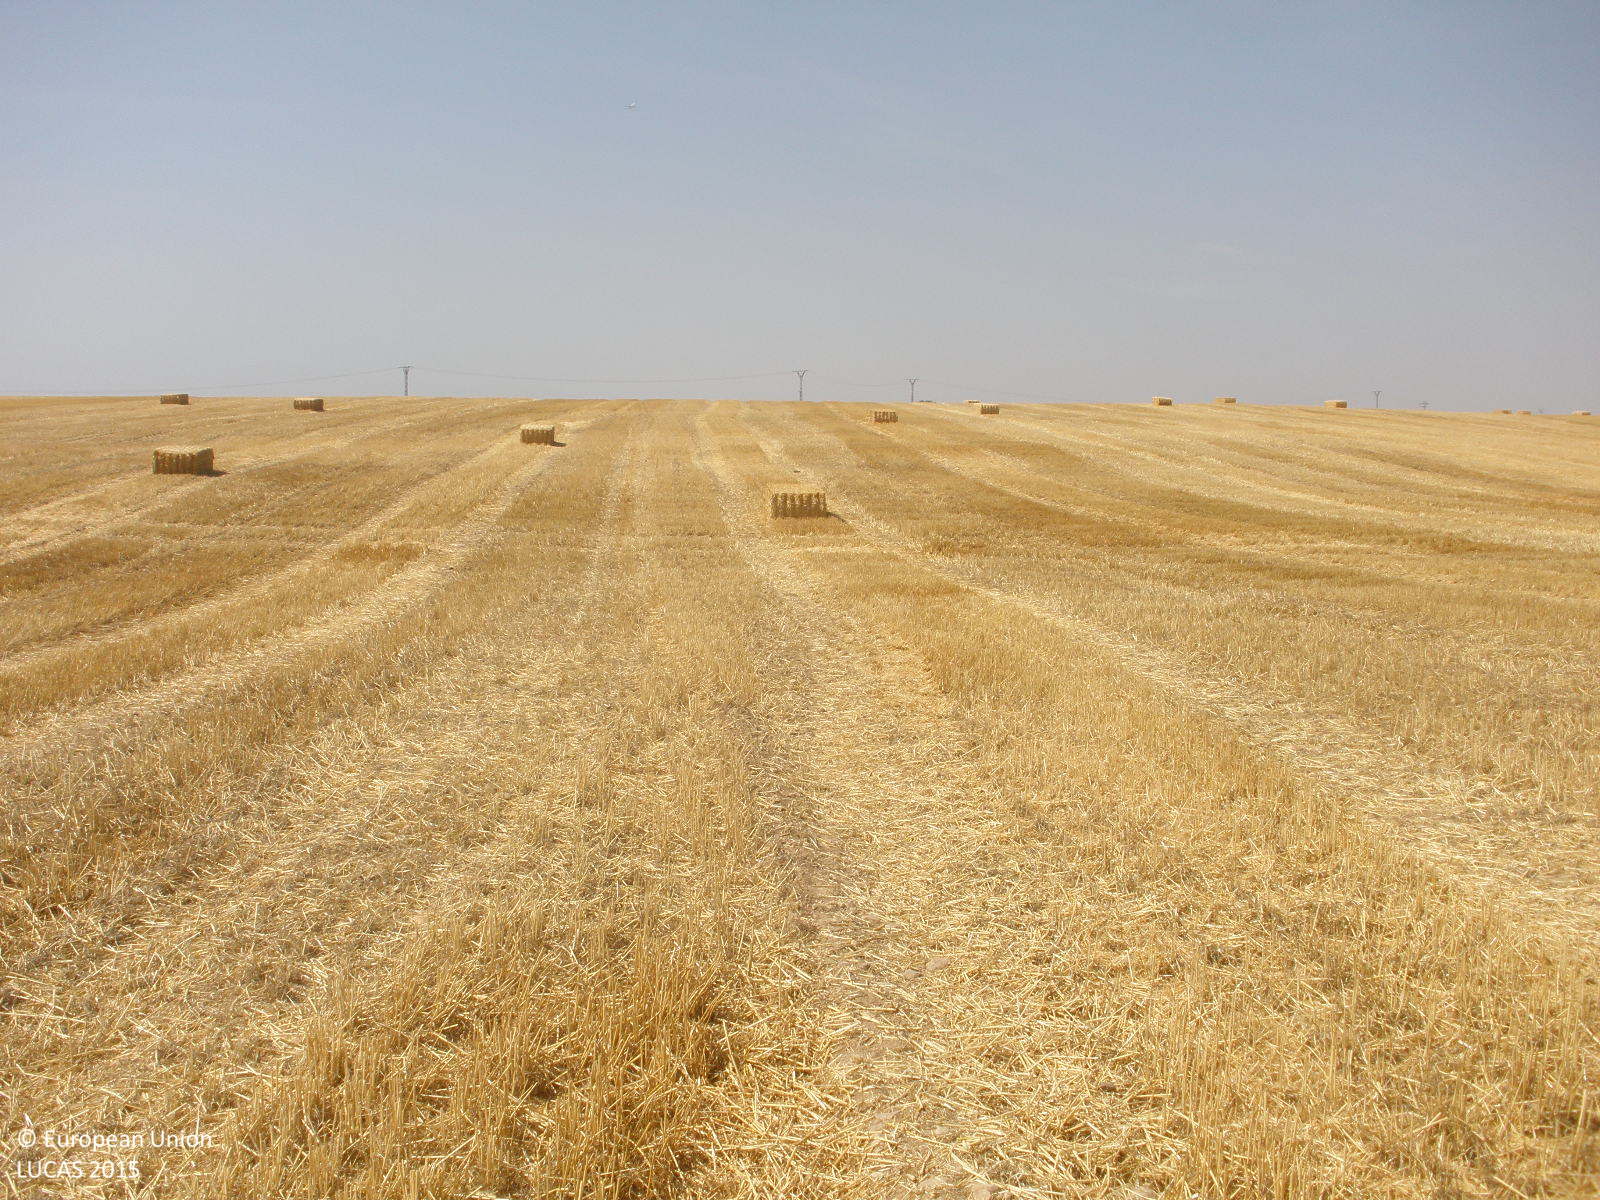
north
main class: Cropland
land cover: Common wheat
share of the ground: < 10 %
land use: Agriculture (excluding fallow land and kitchen gardens)
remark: Harvested field
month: July
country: ES
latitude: 40.3415
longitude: -3.4655
